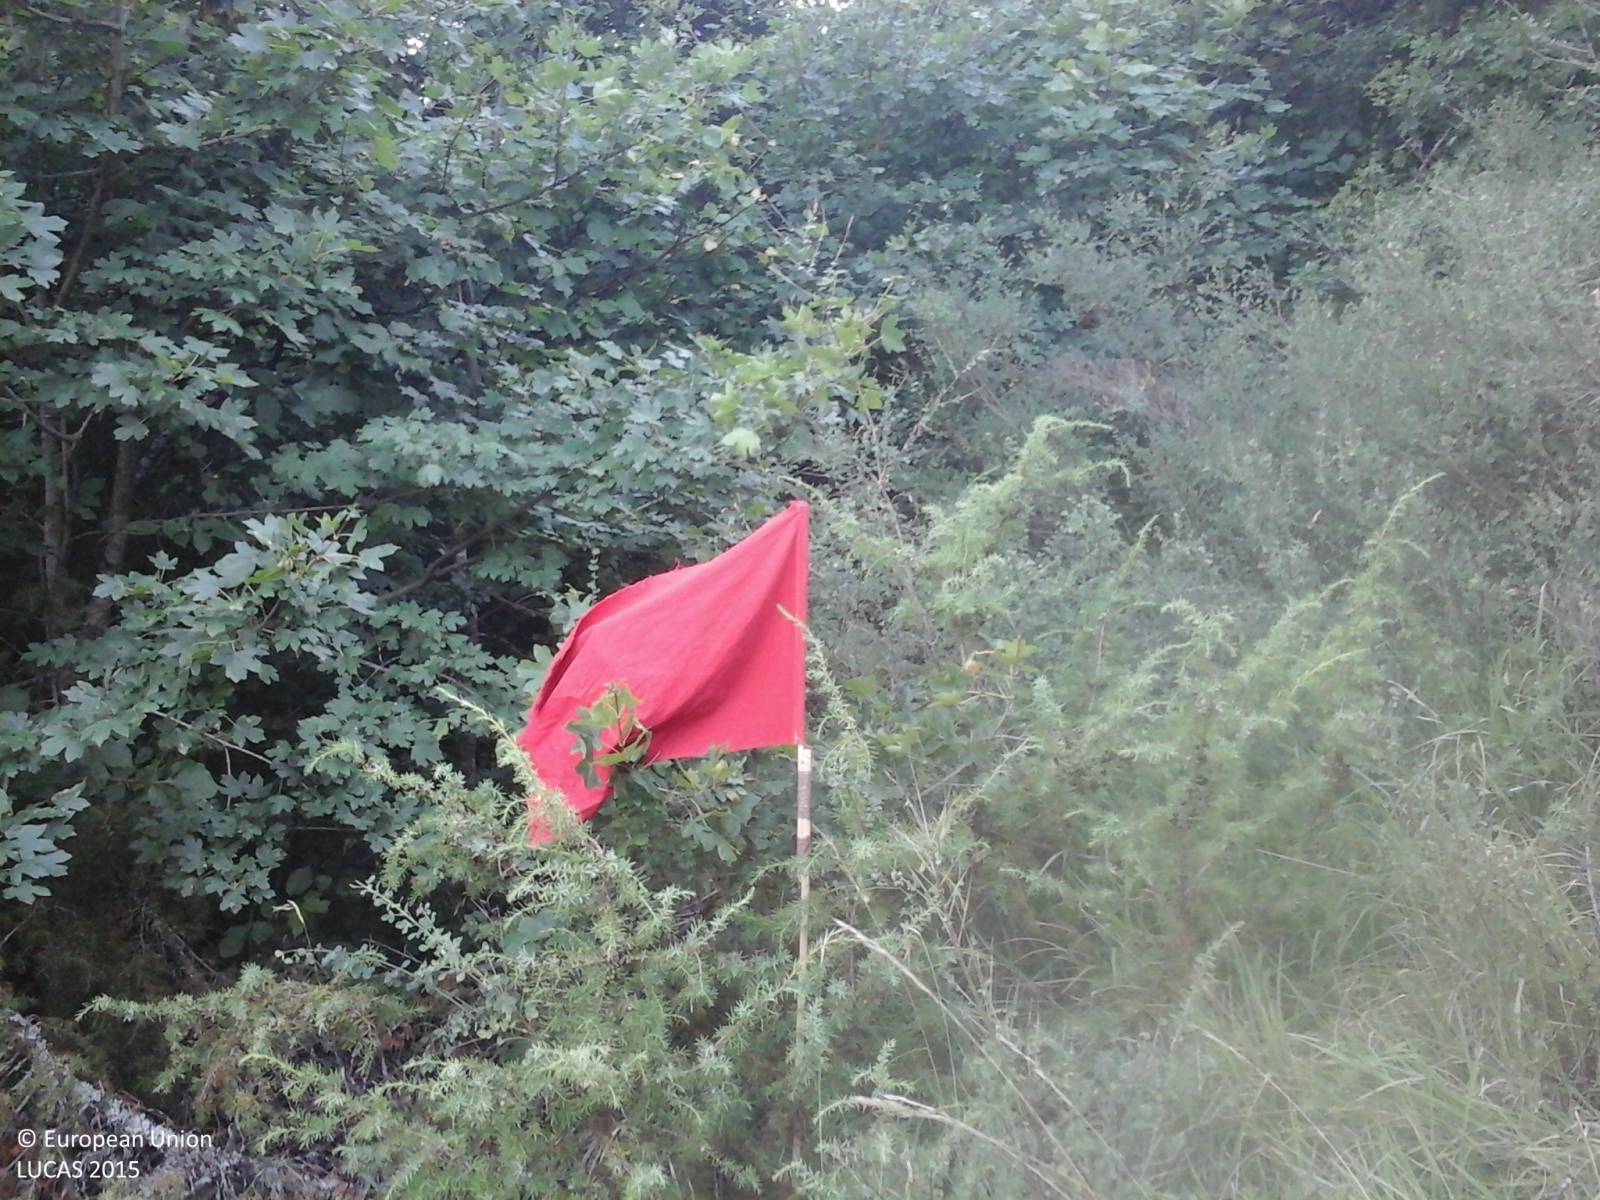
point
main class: Woodland
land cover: Broadleaved woodland
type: thermophilous deciduous forest
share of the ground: > 75 %
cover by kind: broadleaved forest trees 90 %, coniferous forest trees 5 %, shrubs 5 %
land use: Forestry
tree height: < 5 m
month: August
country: IT
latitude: 43.0079
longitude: 12.9727
